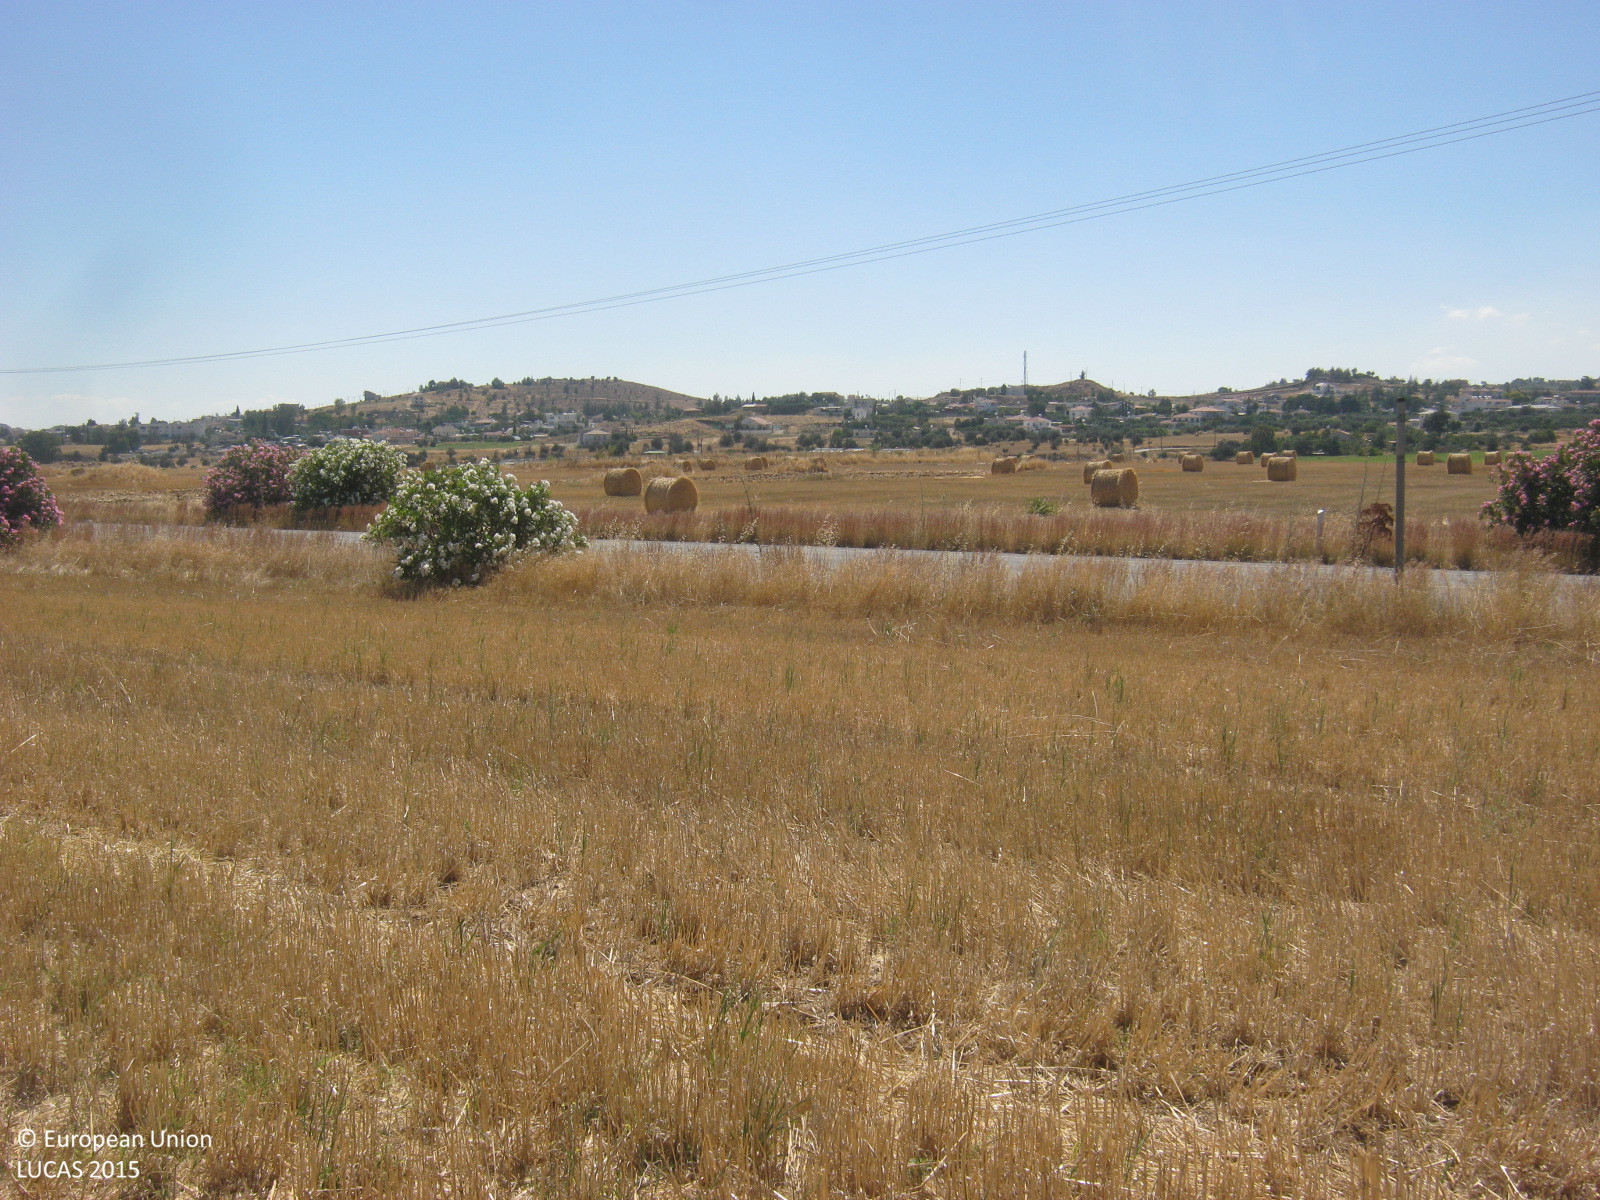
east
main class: Cropland
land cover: Barley
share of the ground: < 10 %
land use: Agriculture (excluding fallow land and kitchen gardens)
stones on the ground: < 10 %
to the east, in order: Barley; Ditches and canals; Paved roads, cycling and walking lanes; Grass margins; Other bare soil; Electric lines; Other bare soil; Fences; Other bare soil; Fences; Grassland with sparse tree/shrub cover
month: June
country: CY
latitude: 35.0325
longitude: 33.1669
